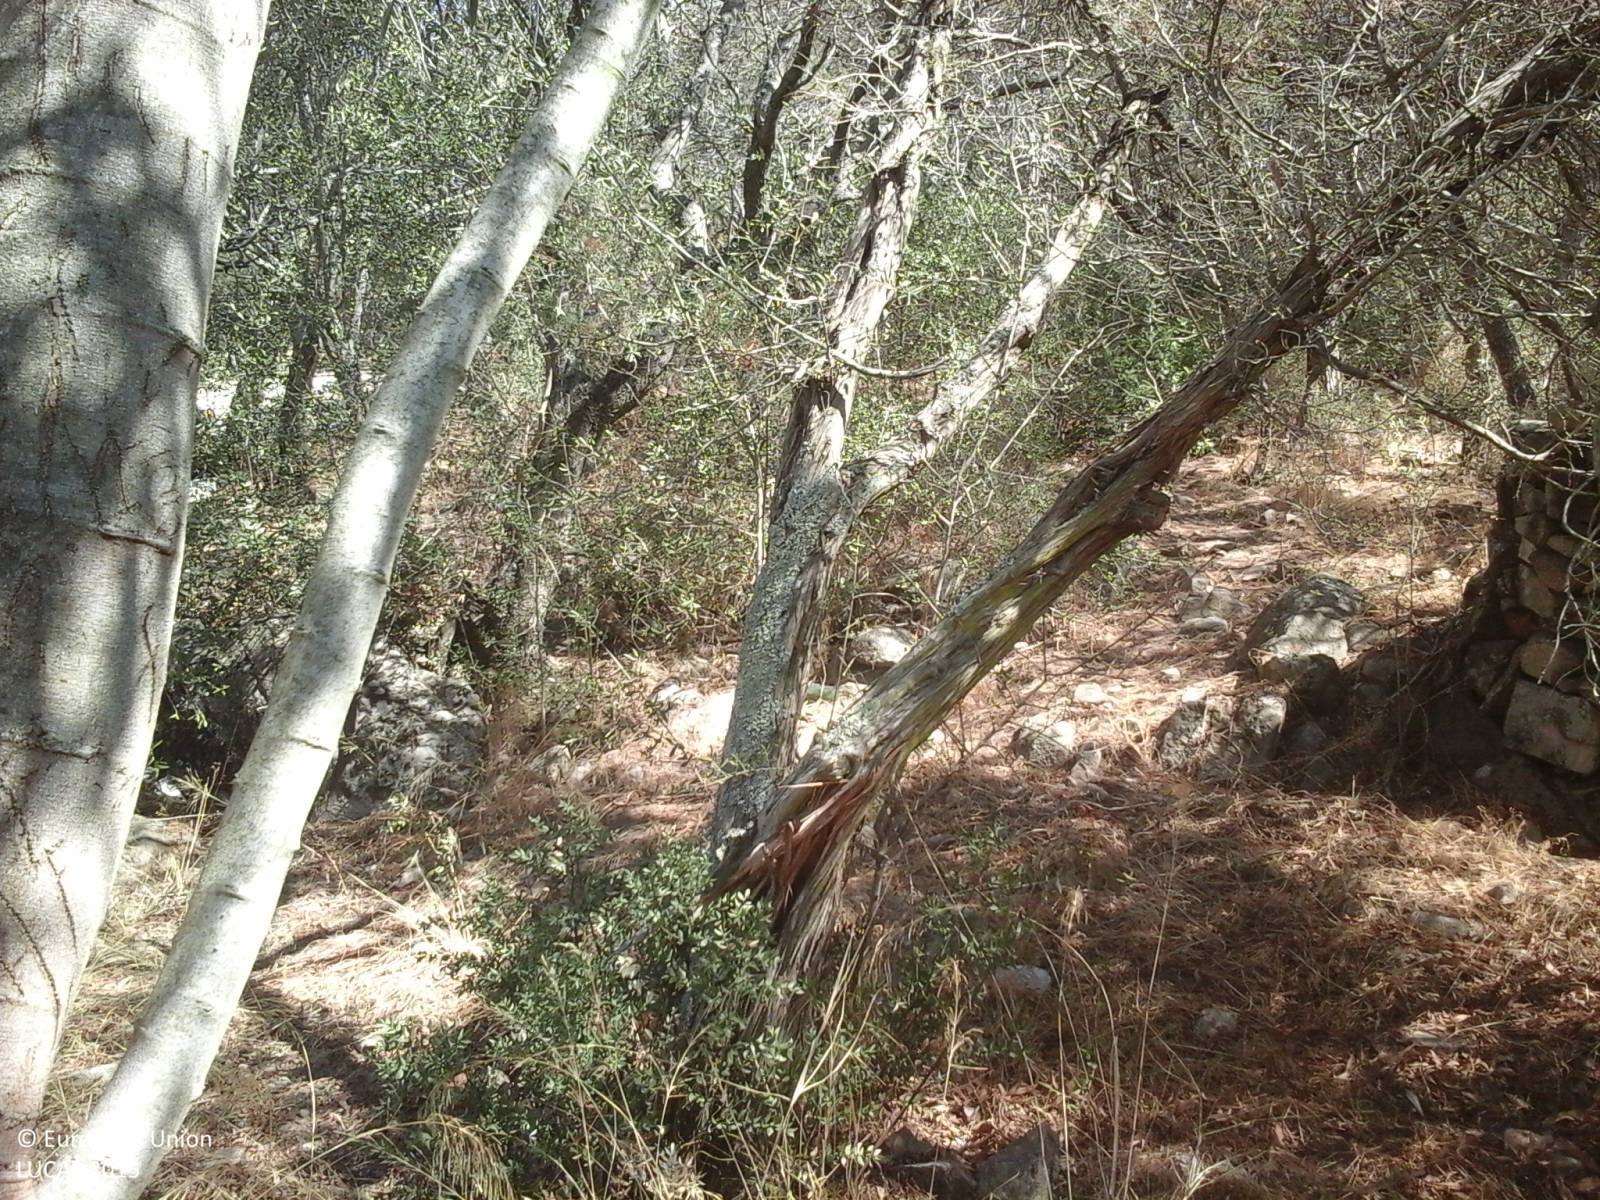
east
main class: Woodland
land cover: Broadleaved woodland
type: broadleaved evergreen forest
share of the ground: > 75 %
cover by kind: broadleaved forest trees 90 %, shrubs 5 %, herbaceous plants 5 %
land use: Residential
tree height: > 5 m
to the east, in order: Broadleaved woodland; Artificial constructions in urban areas; Grassland with sparse tree/shrub cover; Shrubland with sparse tree cover; Artificial constructions in urban areas; Lines of trees; Artificial constructions in urban areas; Broadleaved woodland
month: September
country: IT
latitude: 41.1878
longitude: 9.3235
